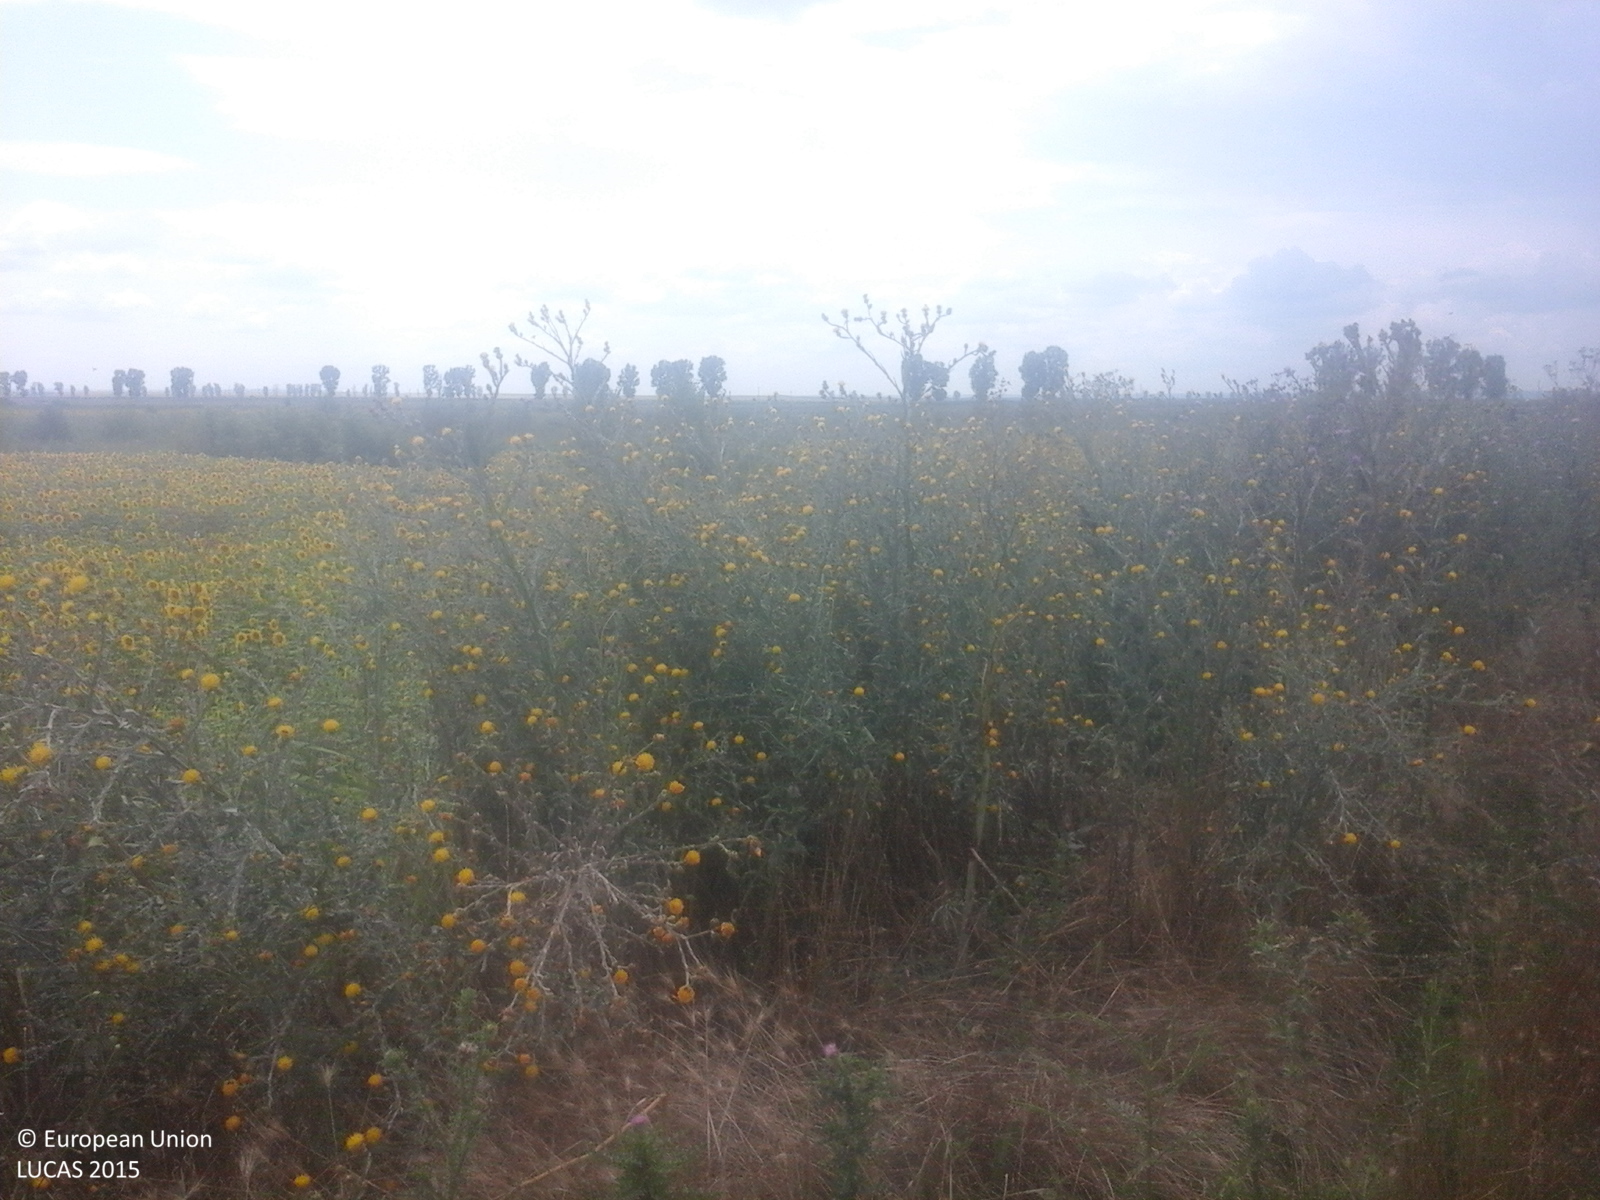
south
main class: Grassland
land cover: Spontaneously vegetated surfaces
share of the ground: > 75 %
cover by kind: herbaceous plants 100 %
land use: Semi-natural and natural areas not in use
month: July
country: RO
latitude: 43.7673
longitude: 24.7397
